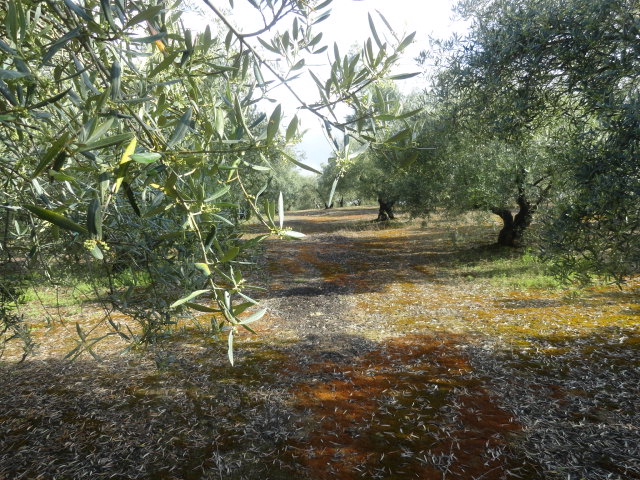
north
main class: Cropland
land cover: Olive groves
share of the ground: > 75 %
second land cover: Spontaneously vegetated surfaces
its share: 10 - 25 %
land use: Agriculture (excluding fallow land and kitchen gardens)
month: April
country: ES
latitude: 37.5881
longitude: -4.6048
